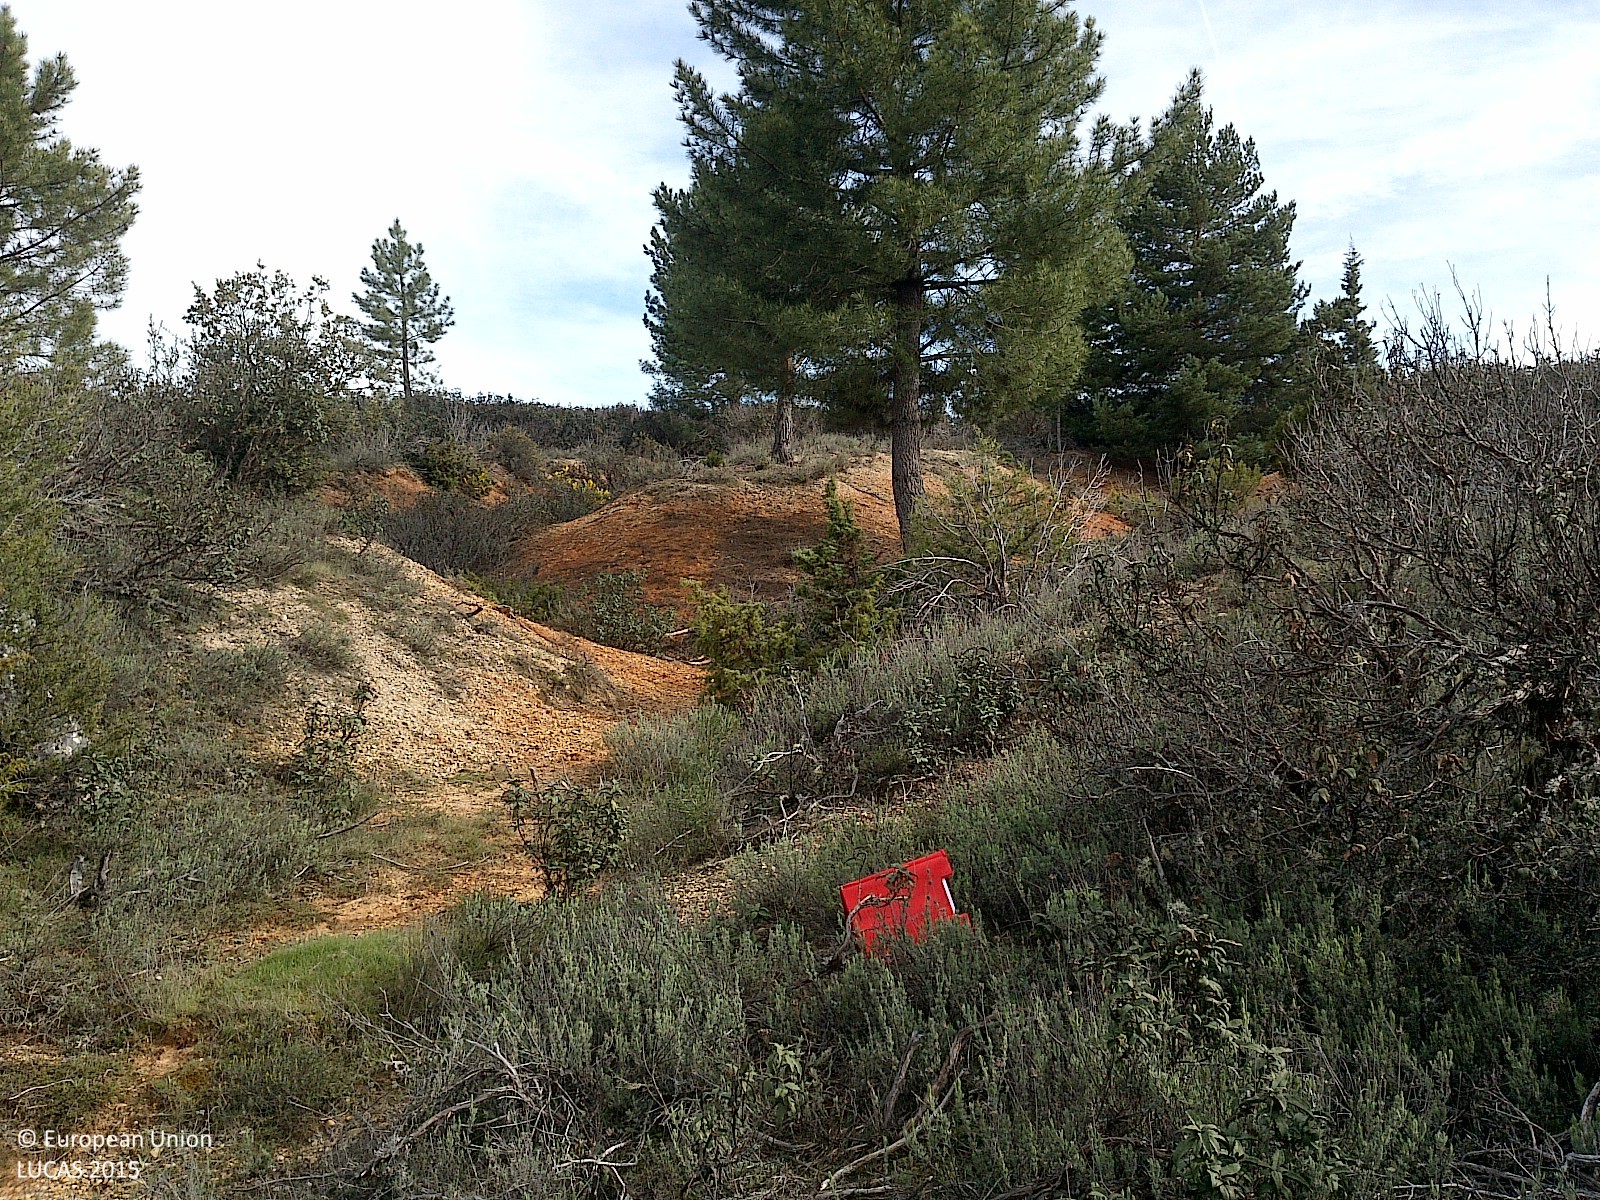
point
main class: Shrubland
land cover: Shrubland with sparse tree cover
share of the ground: 50 - 75 %
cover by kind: shrubs 65 %, herbaceous plants 20 %, unconsolidated bare surface 10 %, coniferous forest trees 5 %
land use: Semi-natural and natural areas not in use
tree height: > 5 m
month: April
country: ES
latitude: 41.7276
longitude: -3.0886
